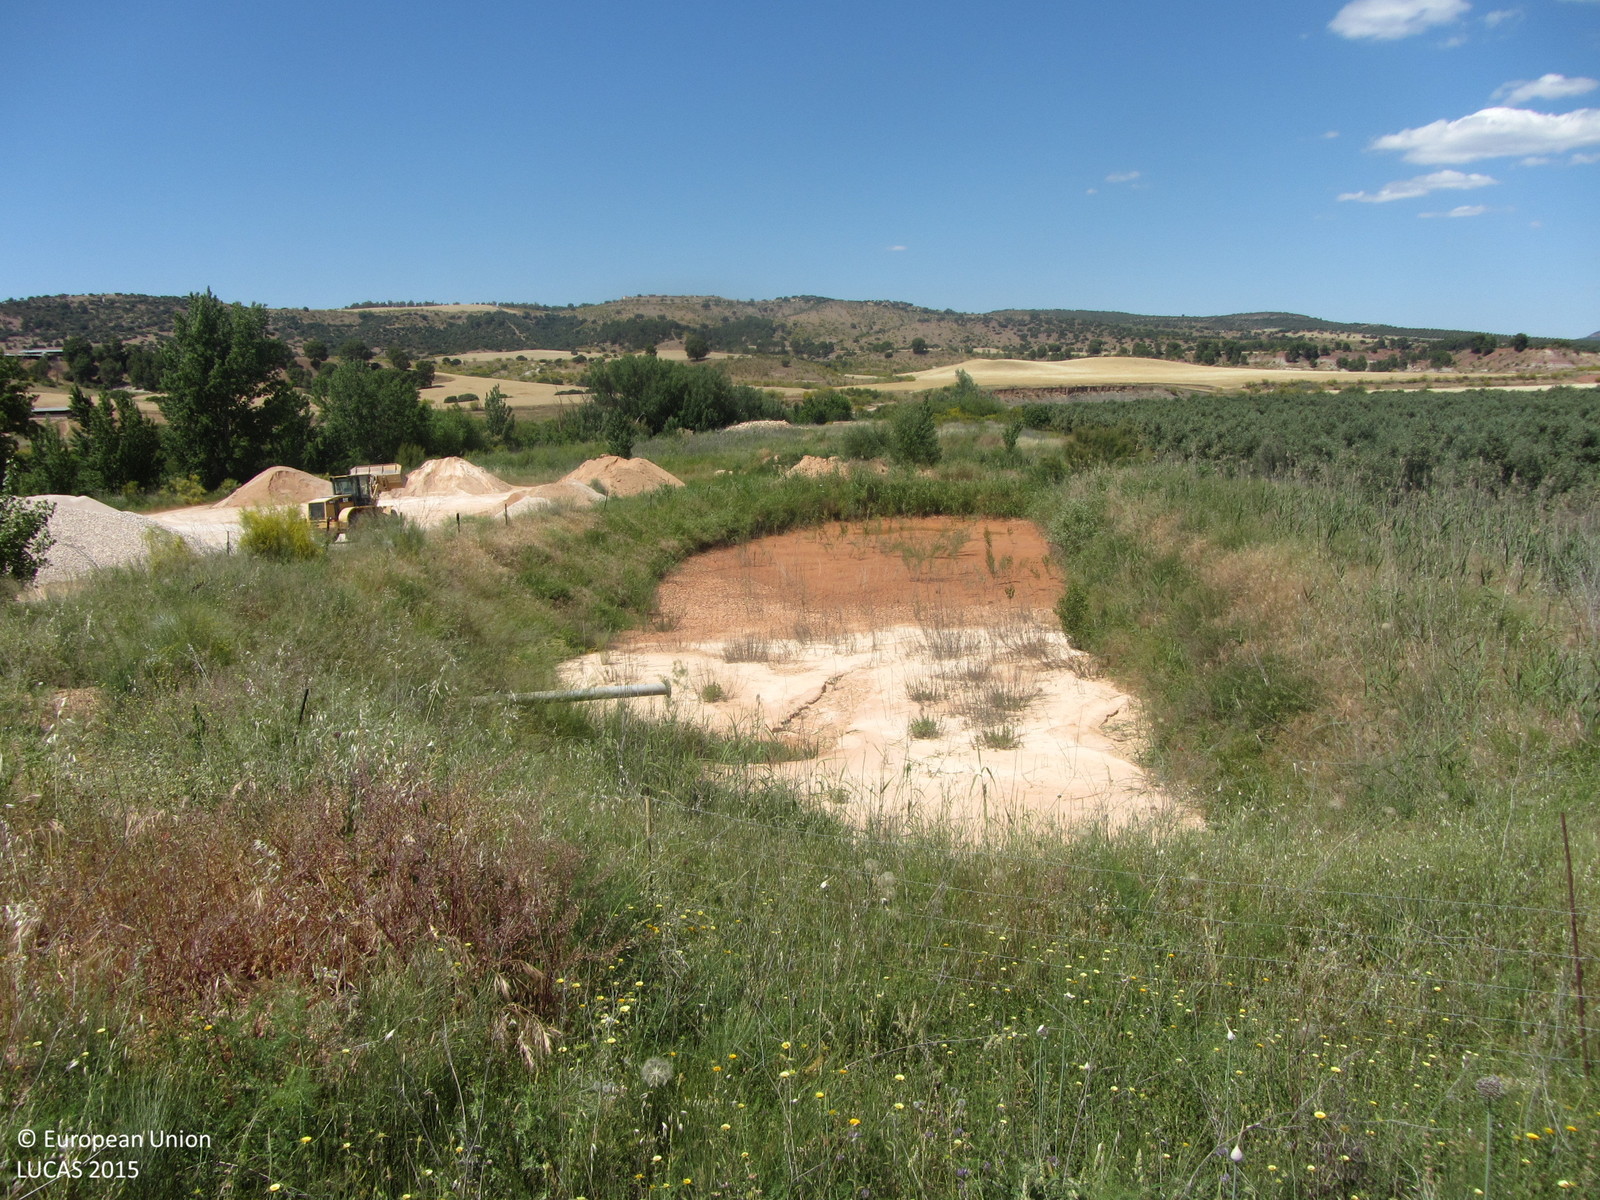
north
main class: Grassland
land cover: Grassland without tree/shrub cover
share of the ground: 50 - 75 %
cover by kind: herbaceous plants 65 %, consolidated bare surface 20 %, shrubs 5 %
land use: Mining and quarrying
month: May
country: ES
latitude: 38.3325
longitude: -2.8929
